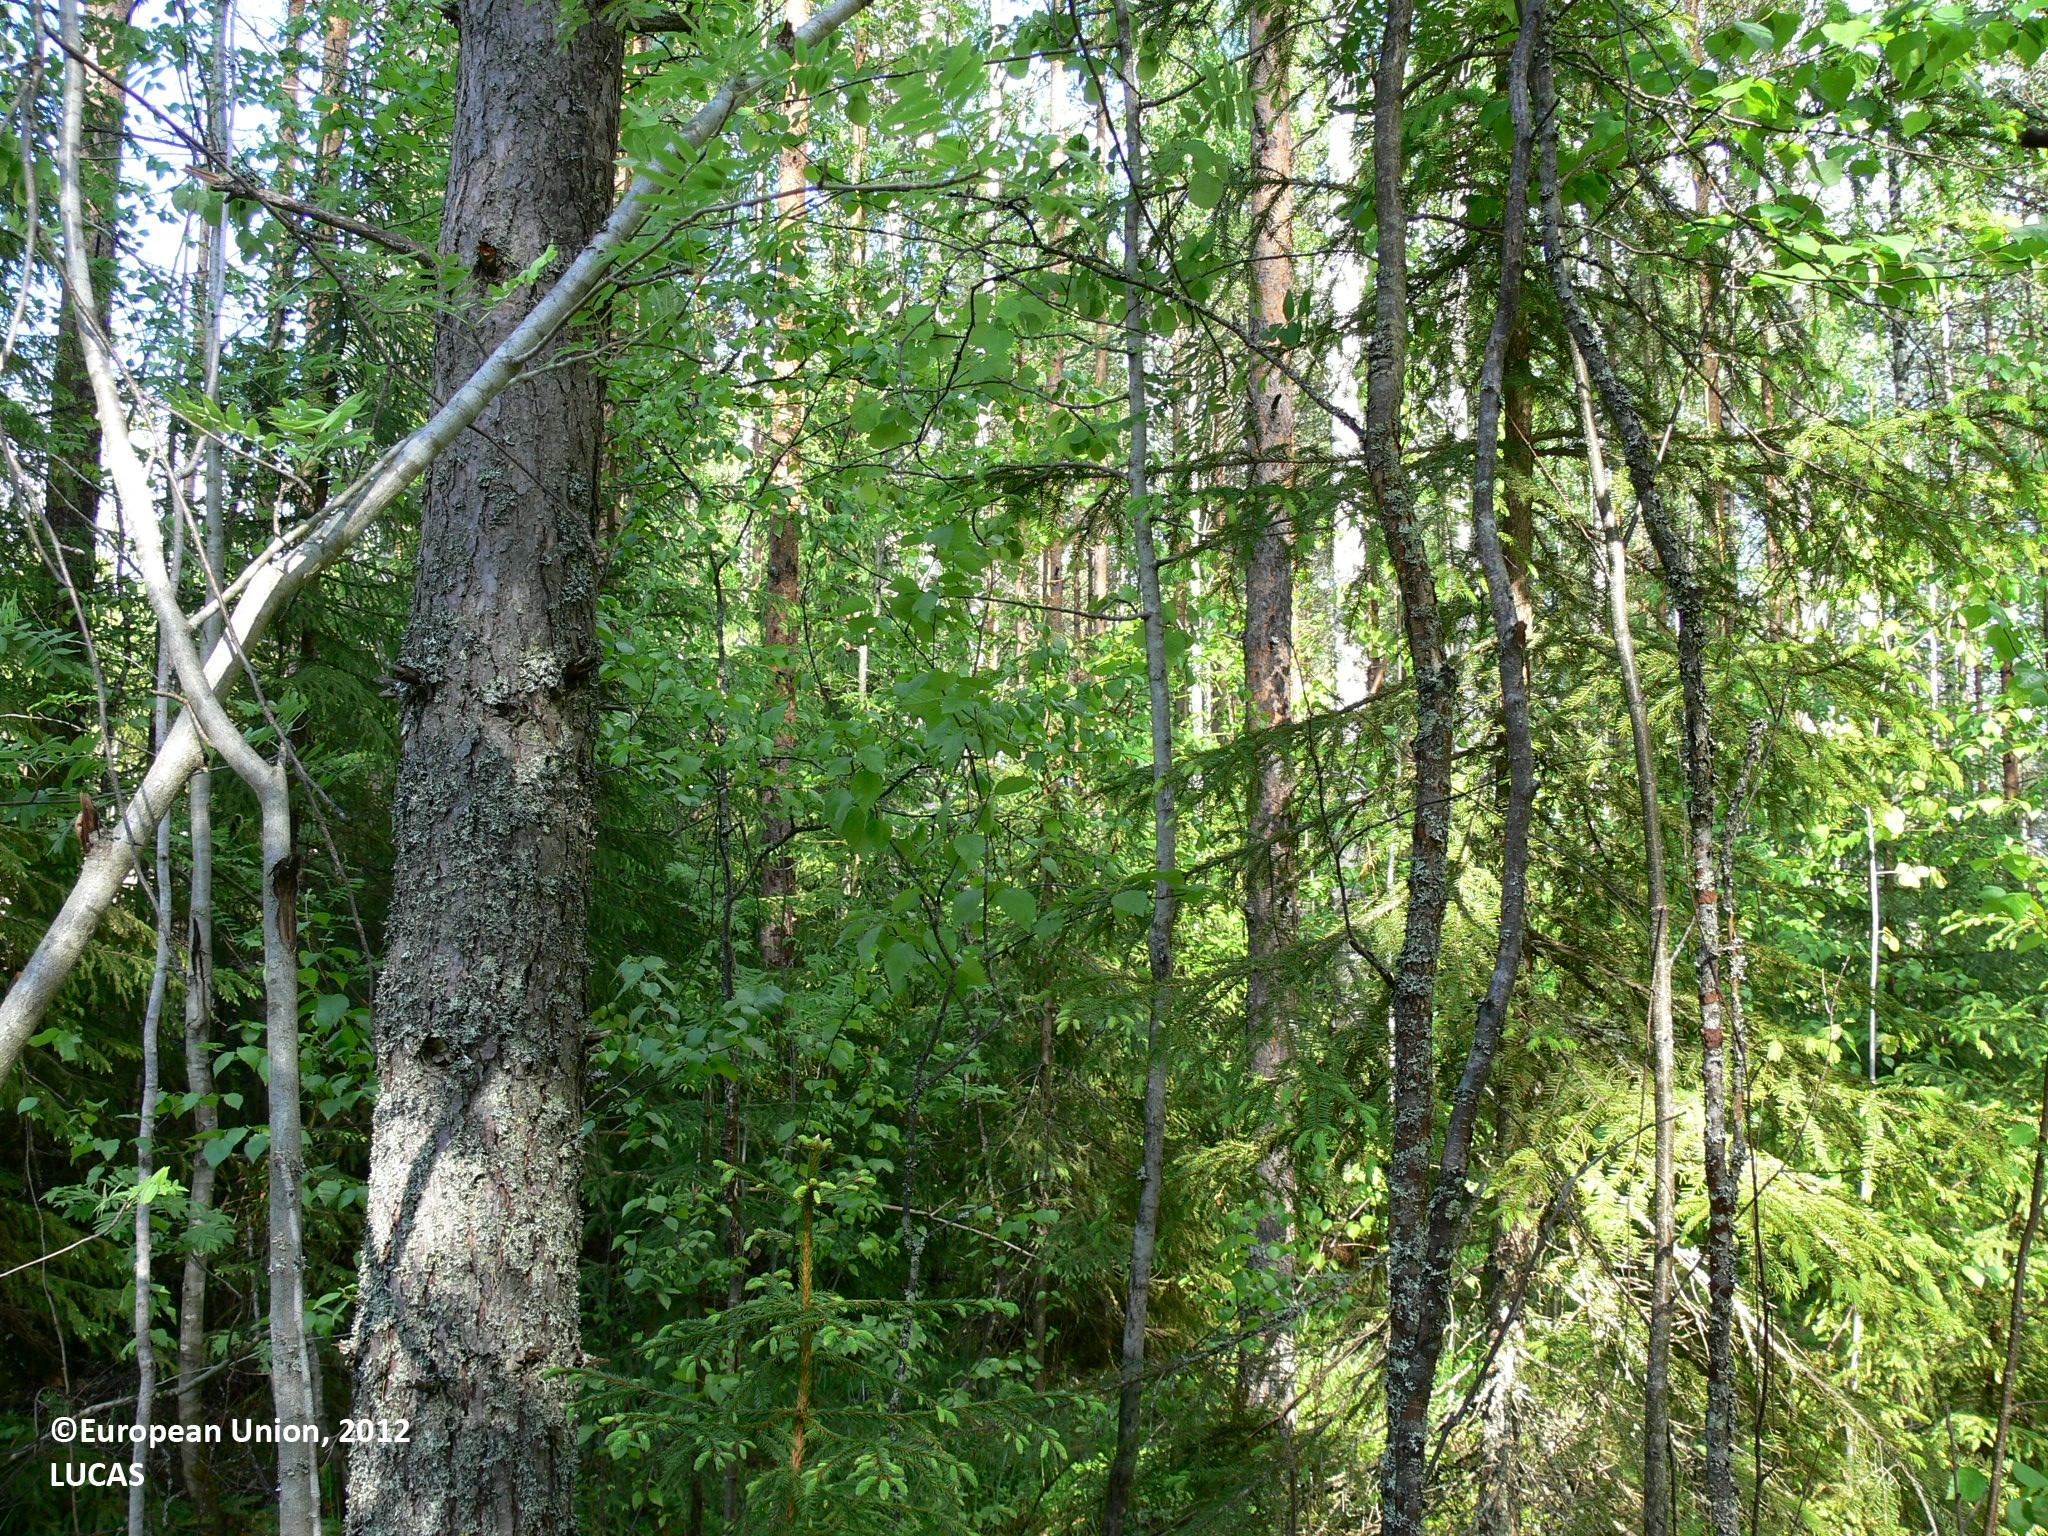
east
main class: Woodland
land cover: Pine dominated mixed woodland
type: boreal forest
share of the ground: > 75 %
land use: Forestry
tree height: > 5 m
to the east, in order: Pine dominated mixed woodland; Other mixed woodland; Pine dominated mixed woodland; Ditches and canals; Pine dominated mixed woodland; Inland water bodies
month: June
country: FI
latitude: 62.4599
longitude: 30.3003
